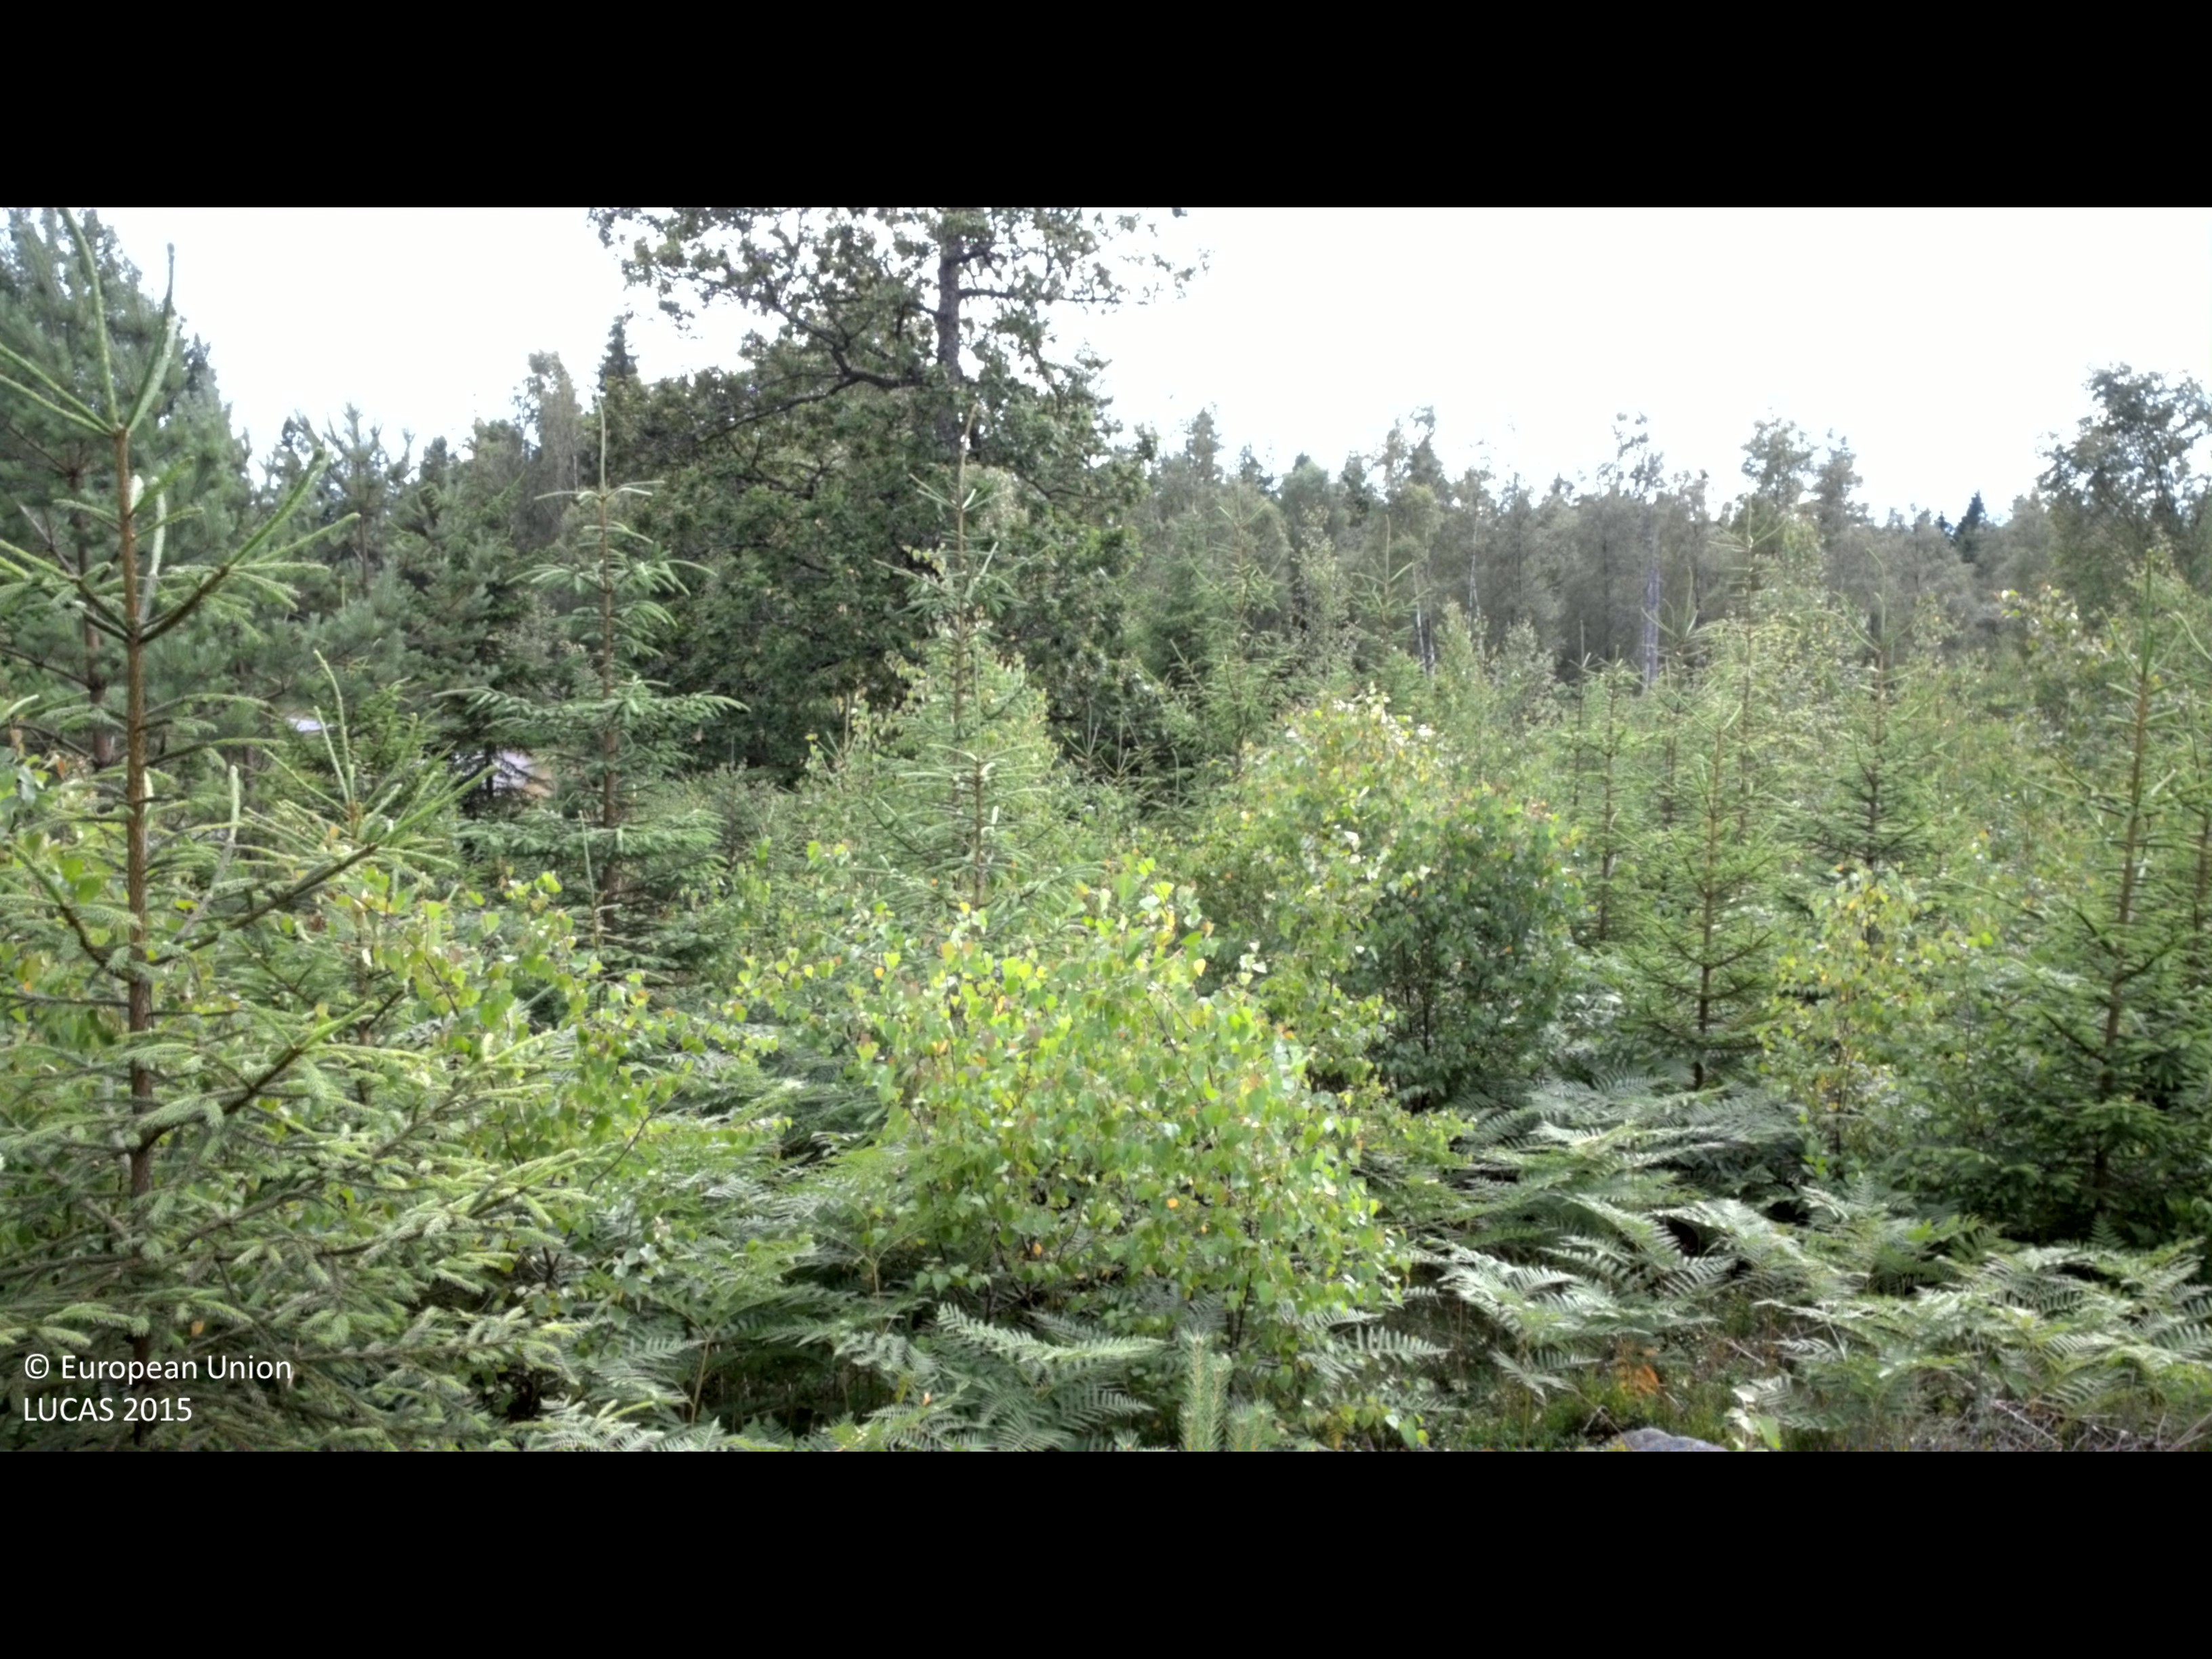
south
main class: Woodland
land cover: Other mixed woodland
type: boreal forest
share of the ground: 50 - 75 %
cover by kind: broadleaved forest trees 40 %, coniferous forest trees 25 %, shrubs 25 %, herbaceous plants 10 %
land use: Forestry
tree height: < 5 m
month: July
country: SE
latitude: 56.5201
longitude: 14.0443
